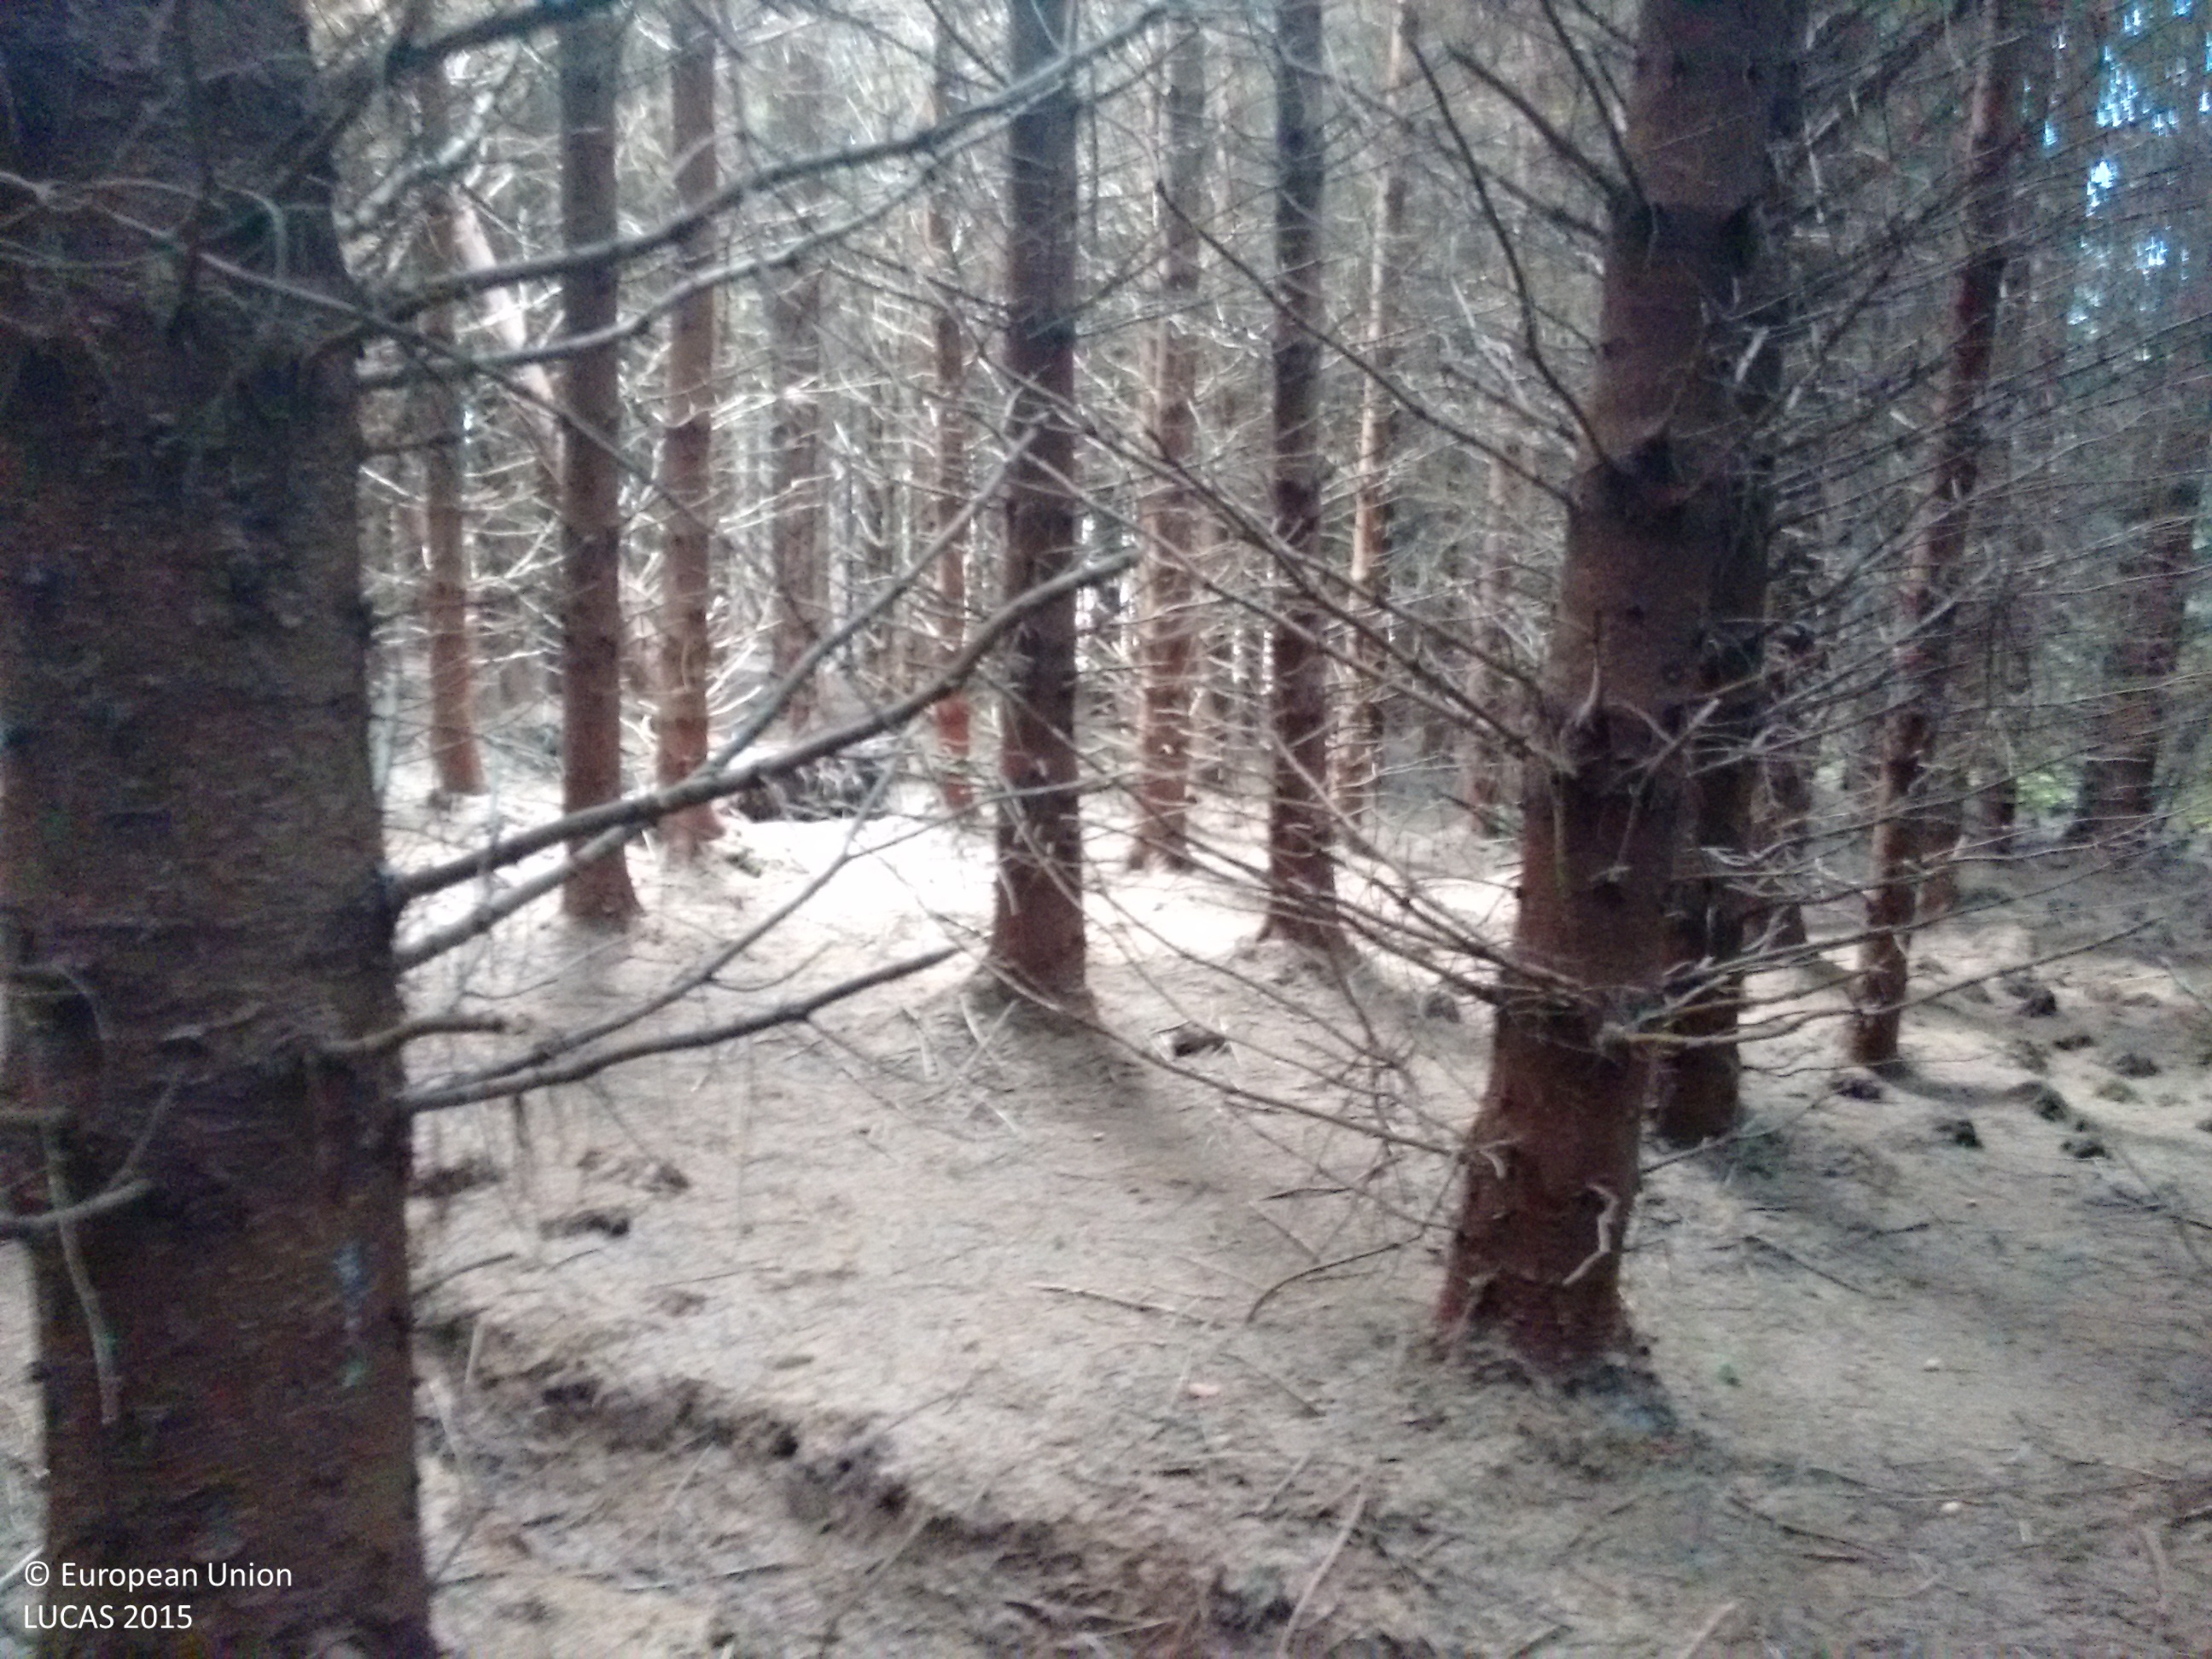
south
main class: Woodland
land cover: Spruce dominated coniferous woodland
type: exotic forest
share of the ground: > 75 %
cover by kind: coniferous forest trees 100 %
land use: Forestry
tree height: > 5 m
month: September
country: IE
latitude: 52.2065
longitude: -9.3529
